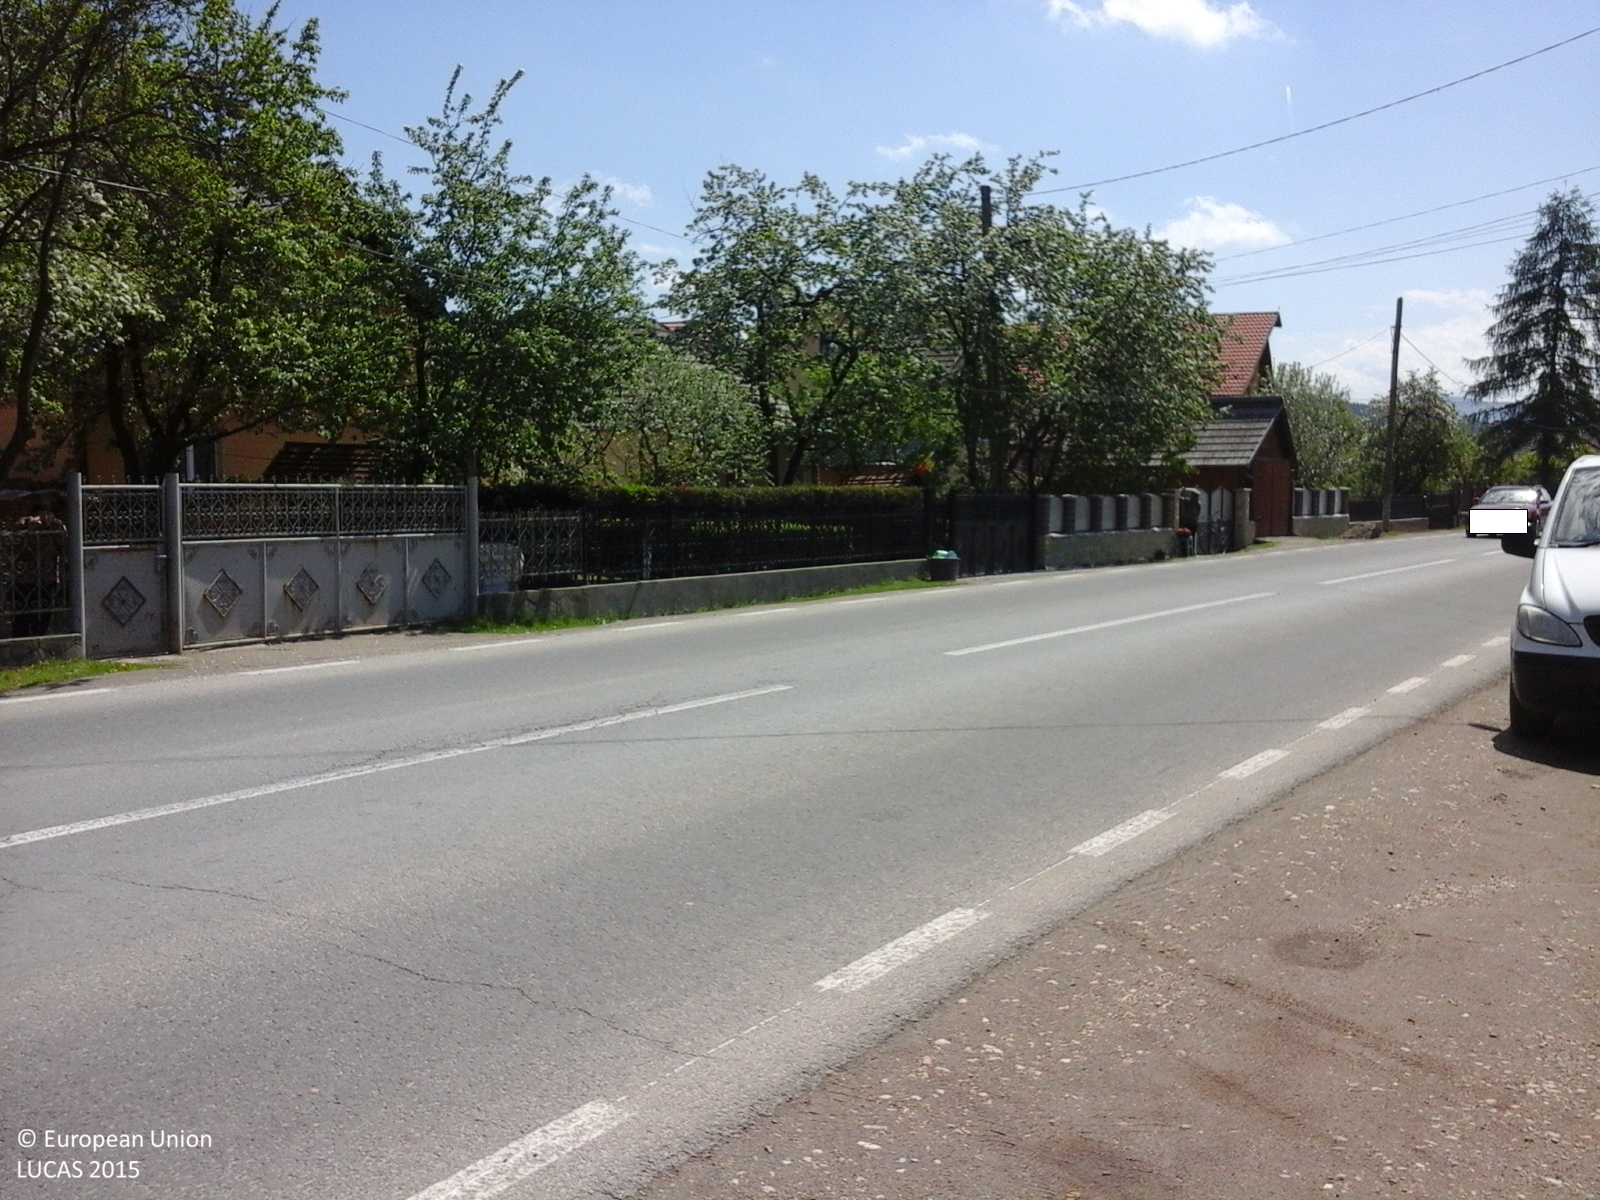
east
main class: Cropland
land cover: Other fruit trees and berries
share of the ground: 10 - 25 %
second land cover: Grassland without tree/shrub cover
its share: > 75 %
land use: Kitchen garden
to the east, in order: Abandoned hedges; Artificial constructions in urban areas; Arable land (only in case pi); Artificial constructions in urban areas; Arable land (only in case pi); Lines of trees; Arable land (only in case pi)
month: May
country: RO
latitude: 45.6585
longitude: 26.0682
